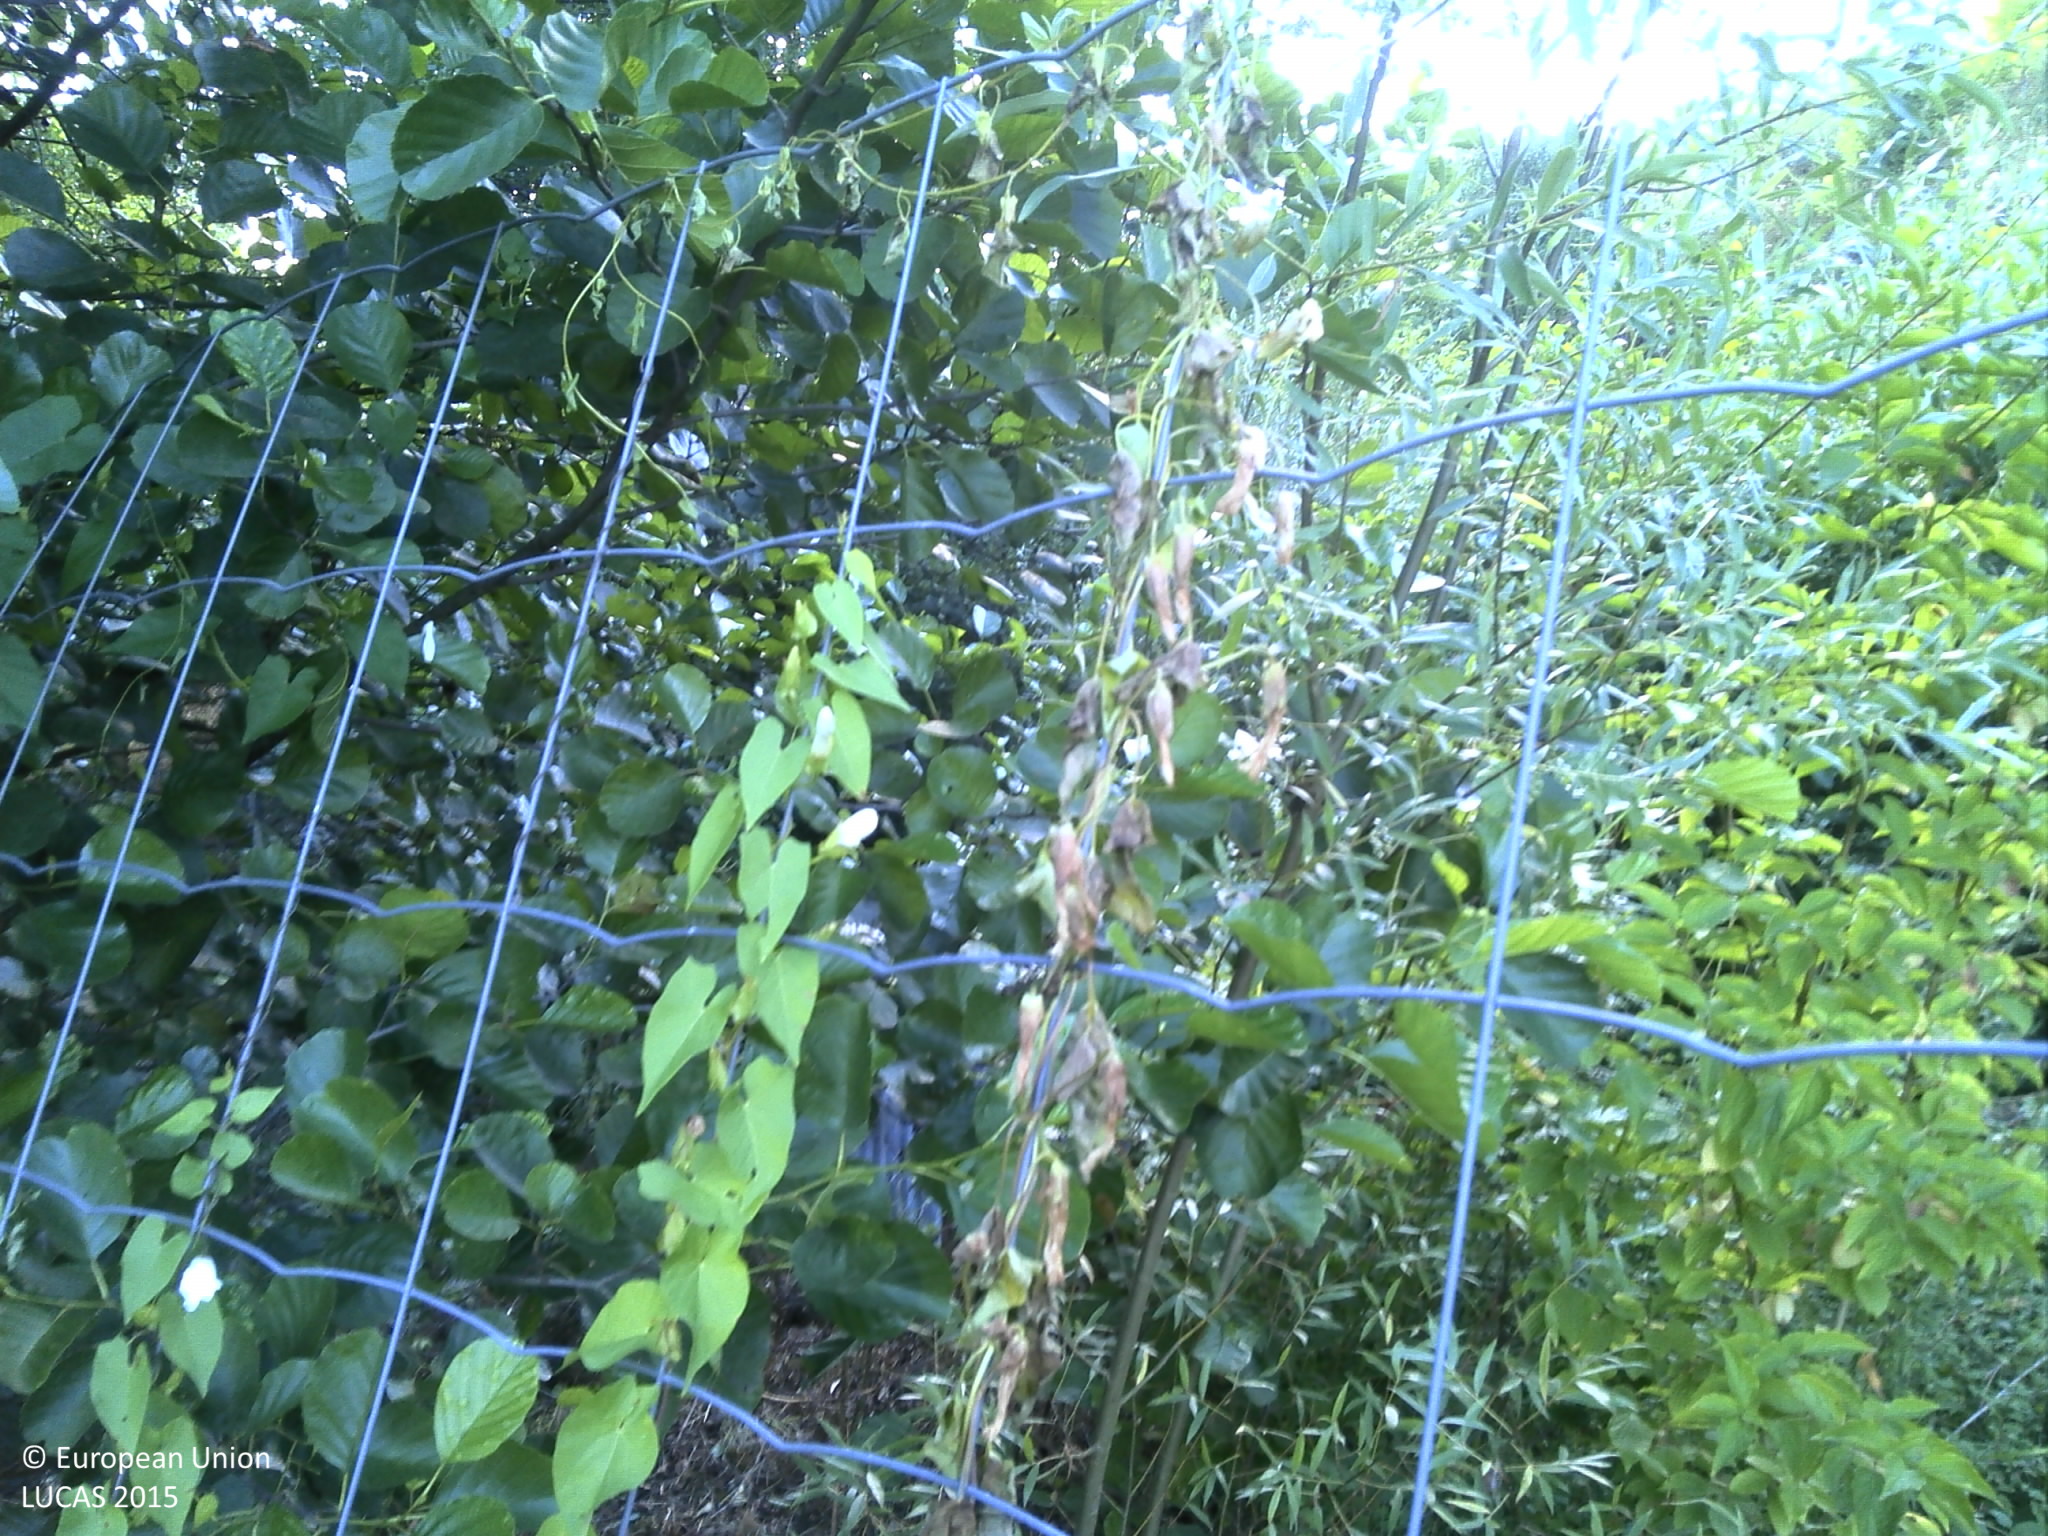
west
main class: Woodland
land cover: Broadleaved woodland
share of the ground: > 75 %
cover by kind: shrubs 50 %, herbaceous plants 30 %, broadleaved forest trees 20 %
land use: Semi-natural and natural areas not in use
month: July
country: FR
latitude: 49.0900
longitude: 7.2755
